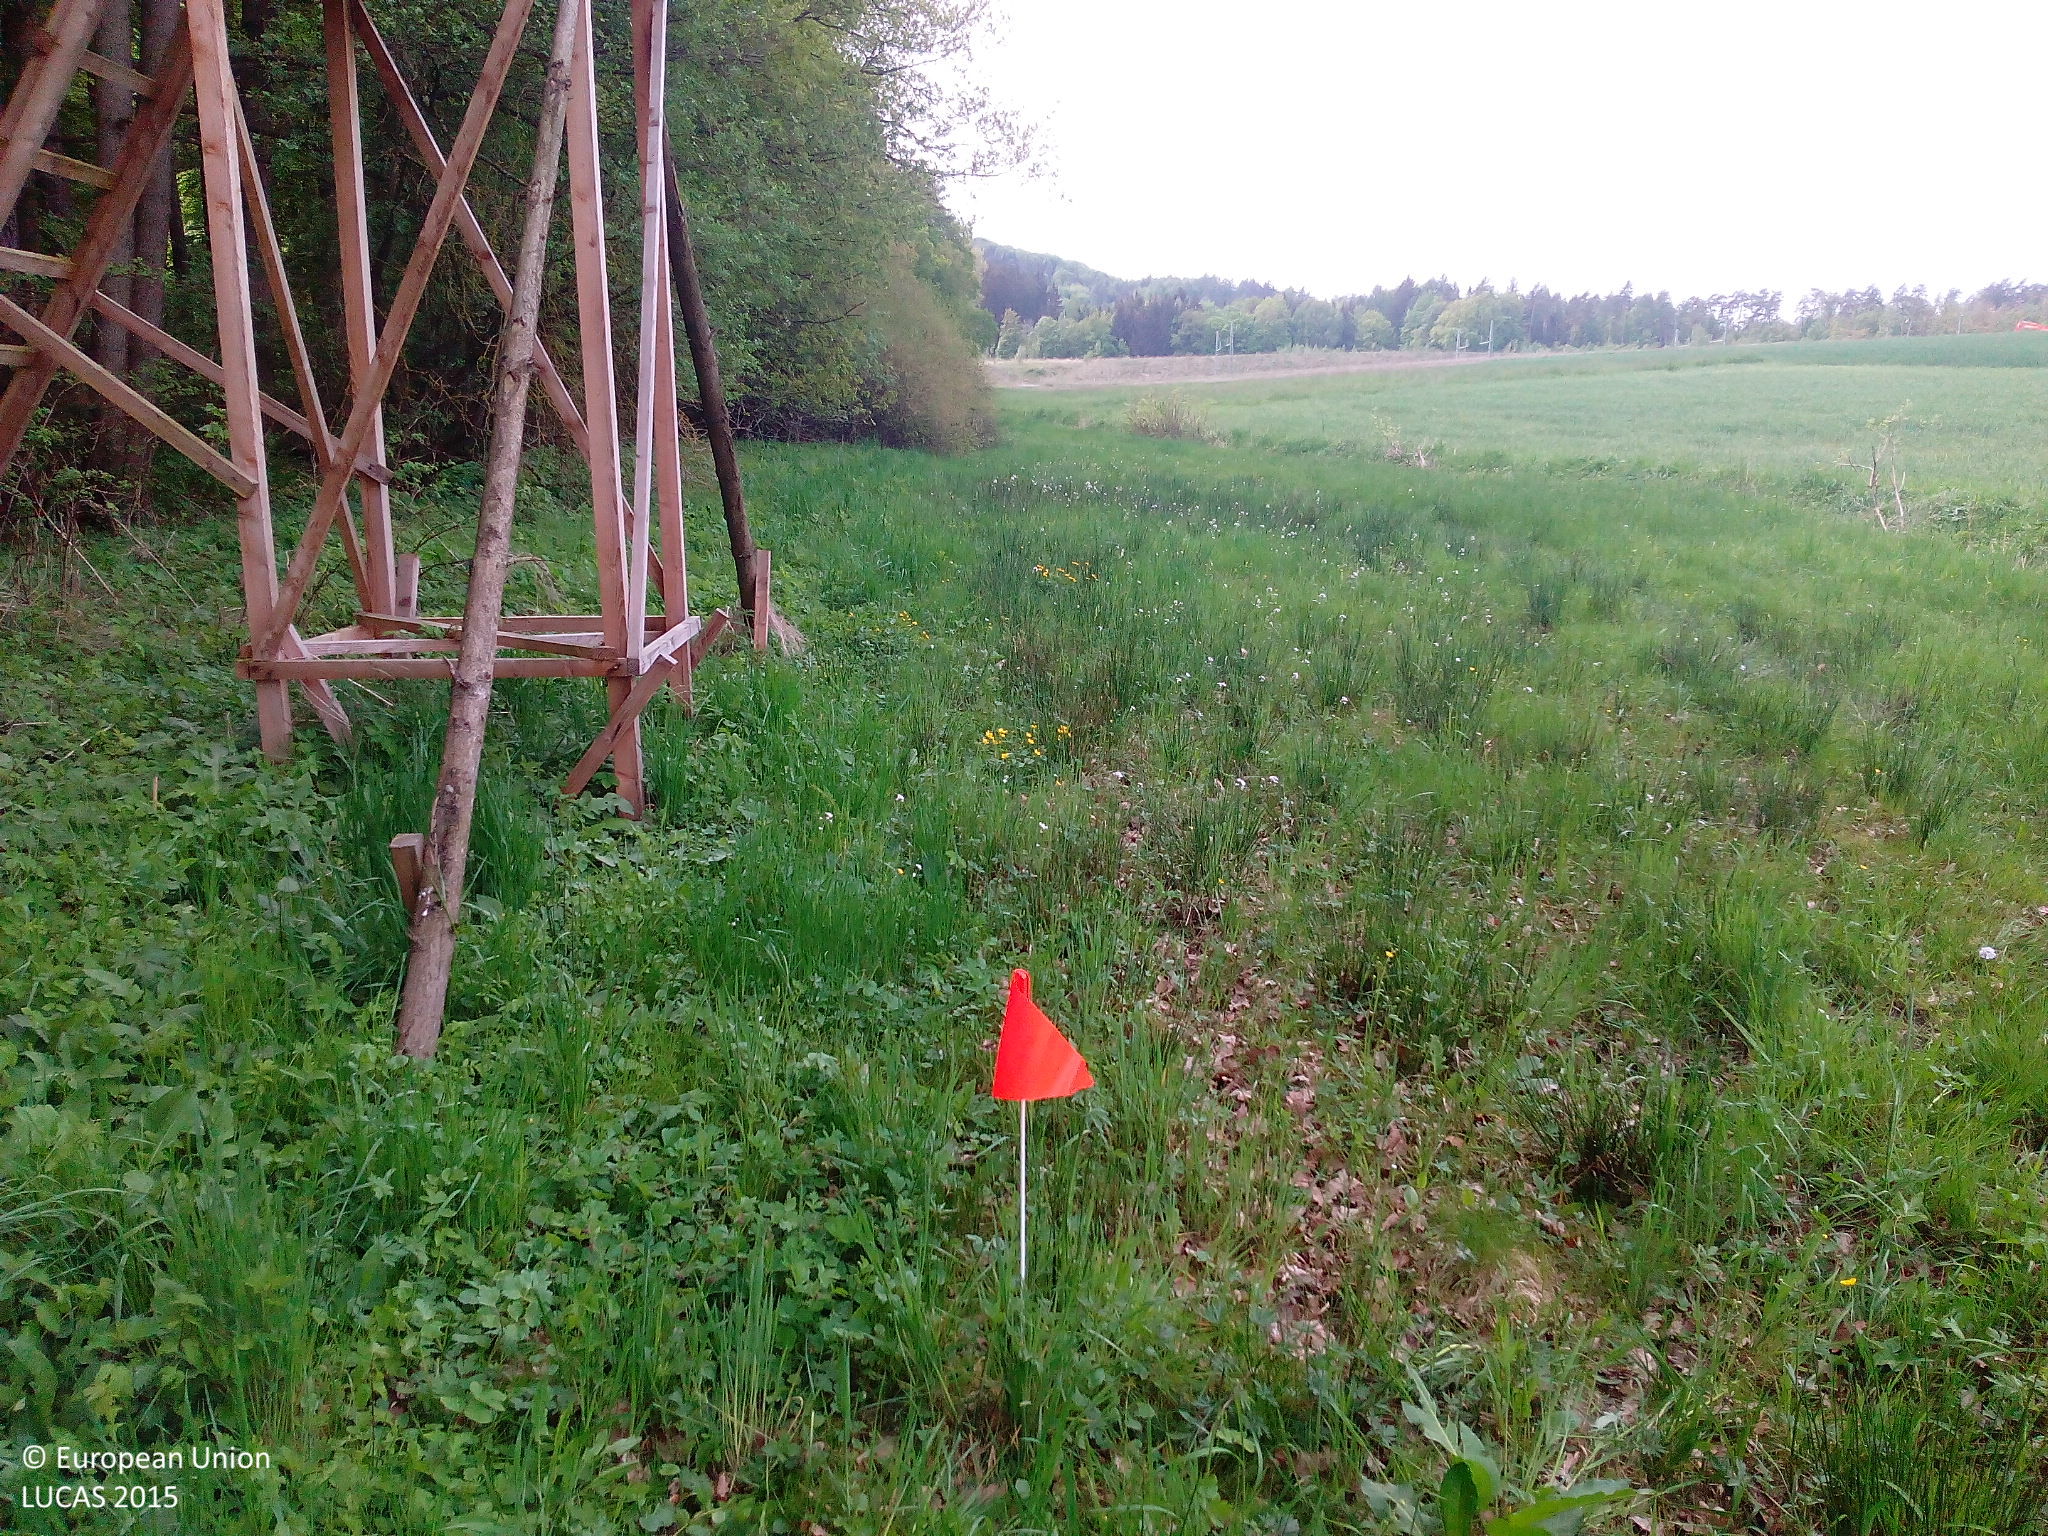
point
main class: Grassland
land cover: Grassland without tree/shrub cover
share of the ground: > 75 %
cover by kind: herbaceous plants 100 %
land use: Agriculture (excluding fallow land and kitchen gardens)
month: May
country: DE
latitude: 50.2696
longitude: 11.0239
